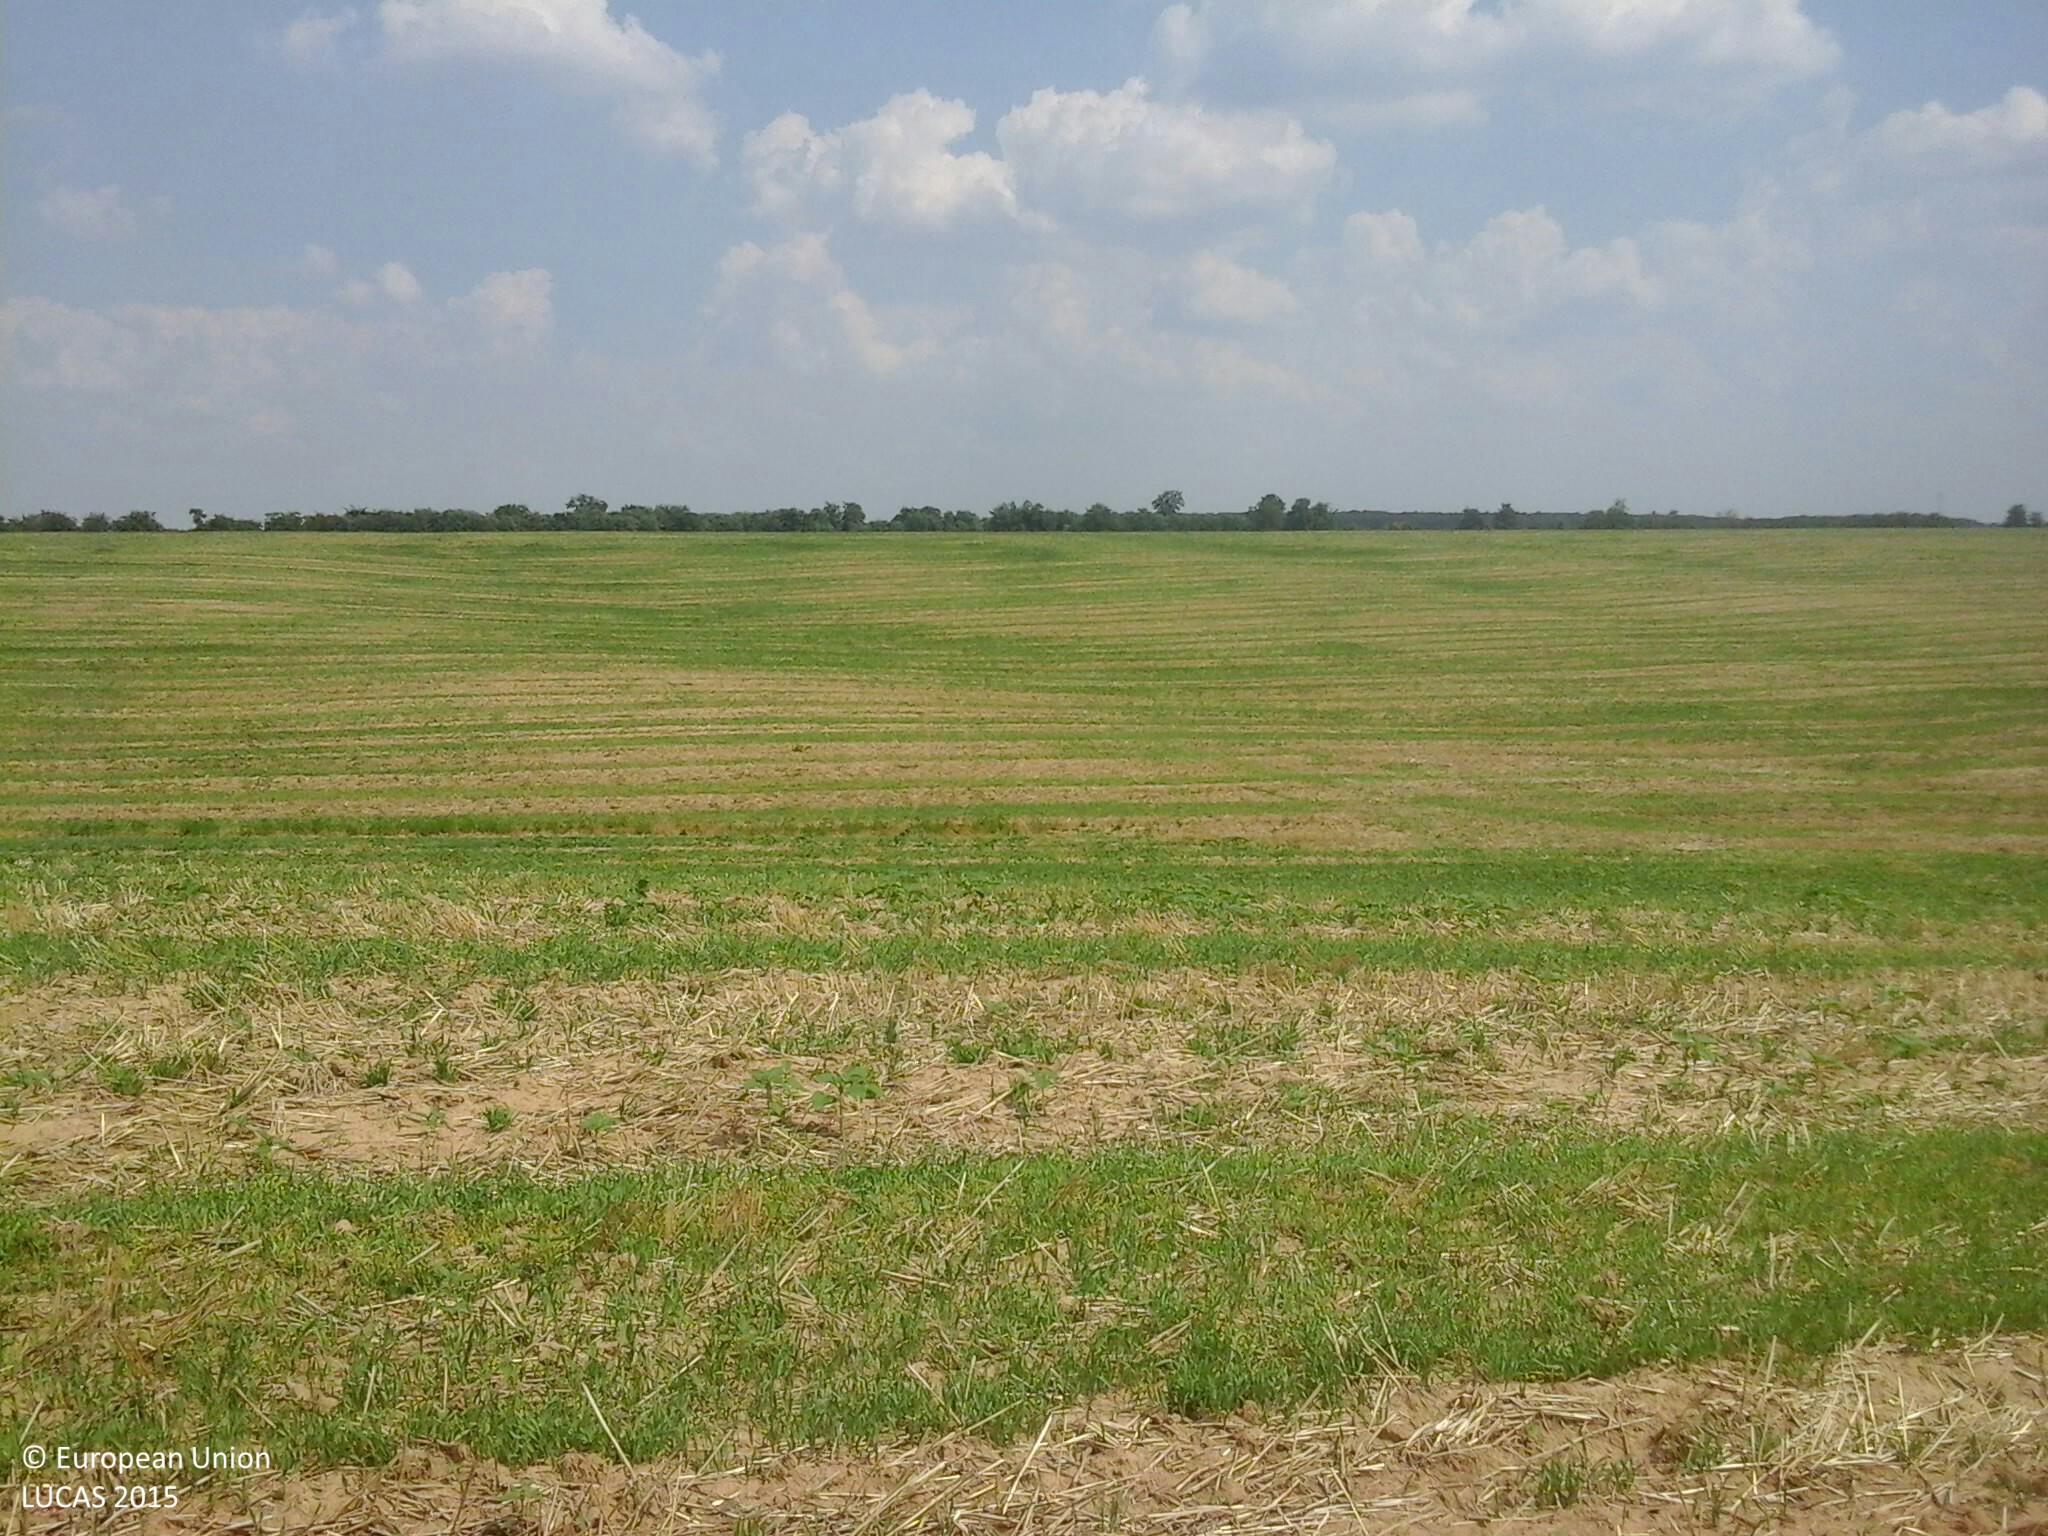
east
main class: Cropland
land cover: Common wheat
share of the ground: 10 - 25 %
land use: Agriculture (excluding fallow land and kitchen gardens)
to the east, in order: Common wheat
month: August
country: HU
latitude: 45.9457
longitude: 18.1978
